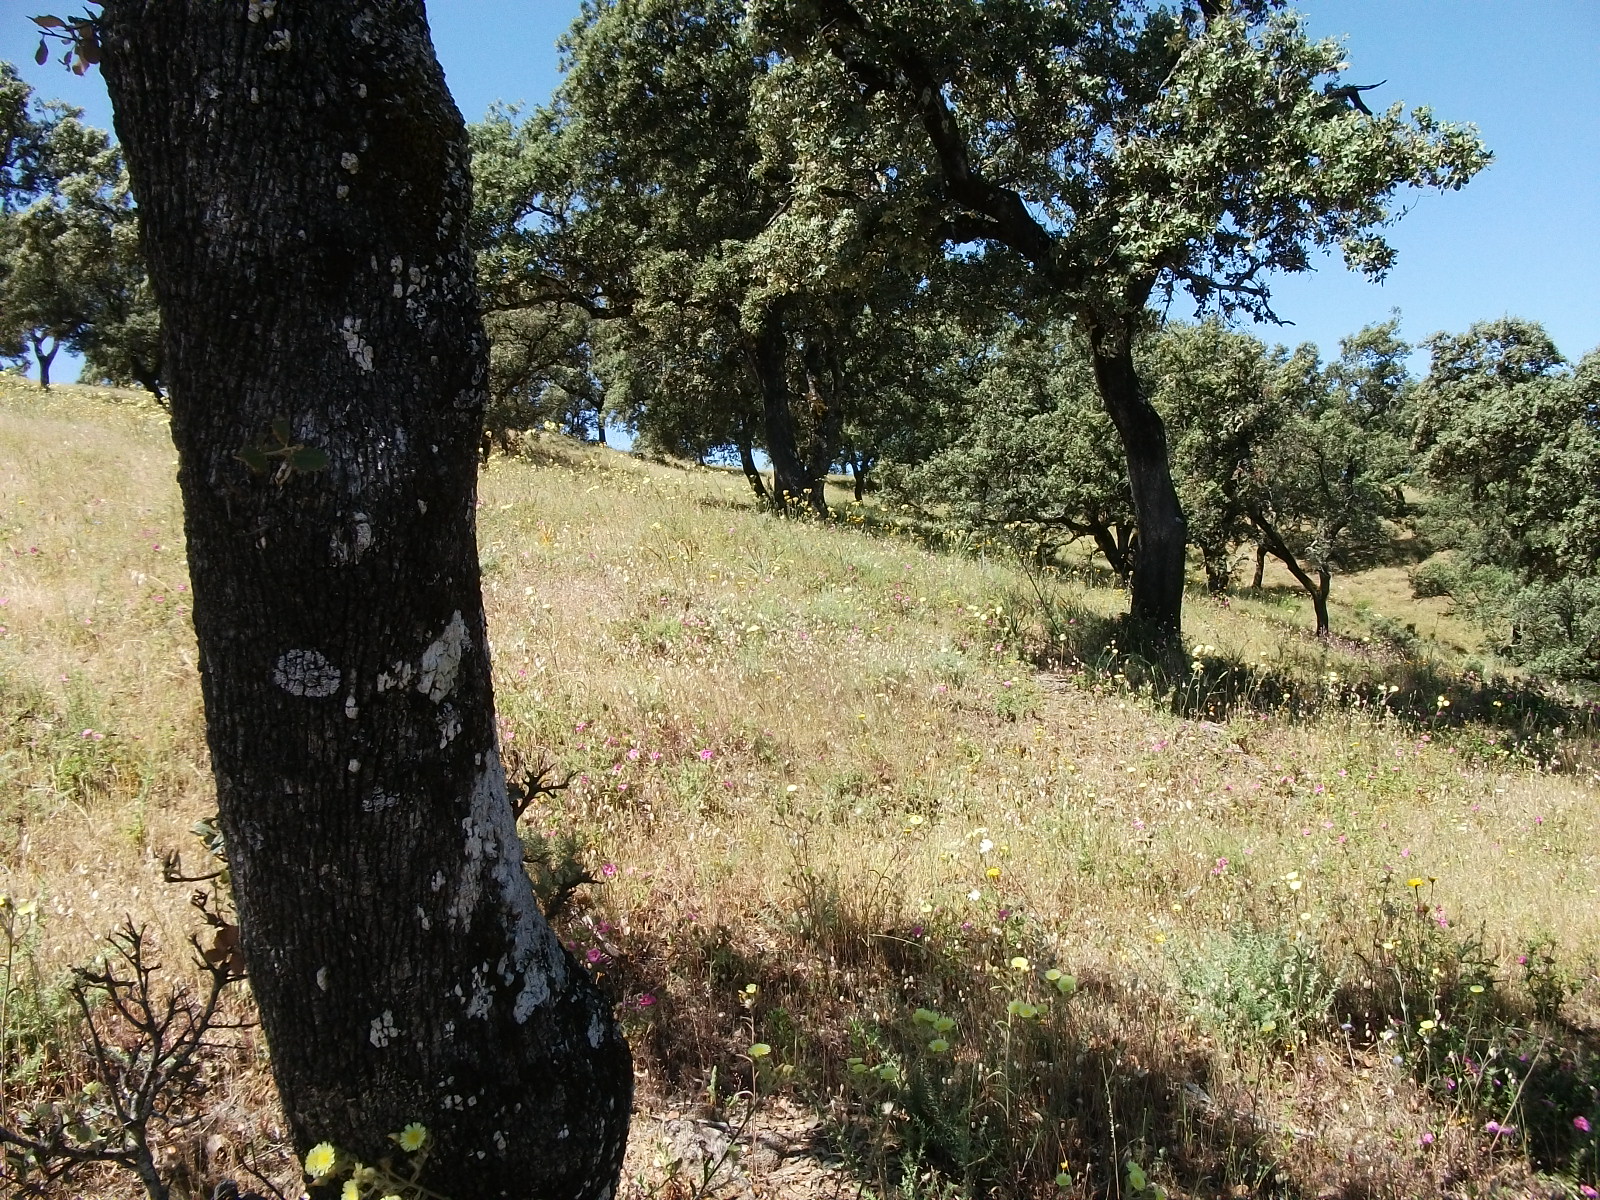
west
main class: Woodland
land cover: Broadleaved woodland
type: broadleaved evergreen forest
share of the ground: 25 - 50 %
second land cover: Spontaneously vegetated surfaces
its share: 50 - 75 %
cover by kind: herbaceous plants 60 %, broadleaved forest trees 40 %
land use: Forestry
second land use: Agriculture (excluding fallow land and kitchen gardens)
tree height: > 5 m
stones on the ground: 25 - 50 %
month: May
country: ES
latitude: 37.9562
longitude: -6.6050
